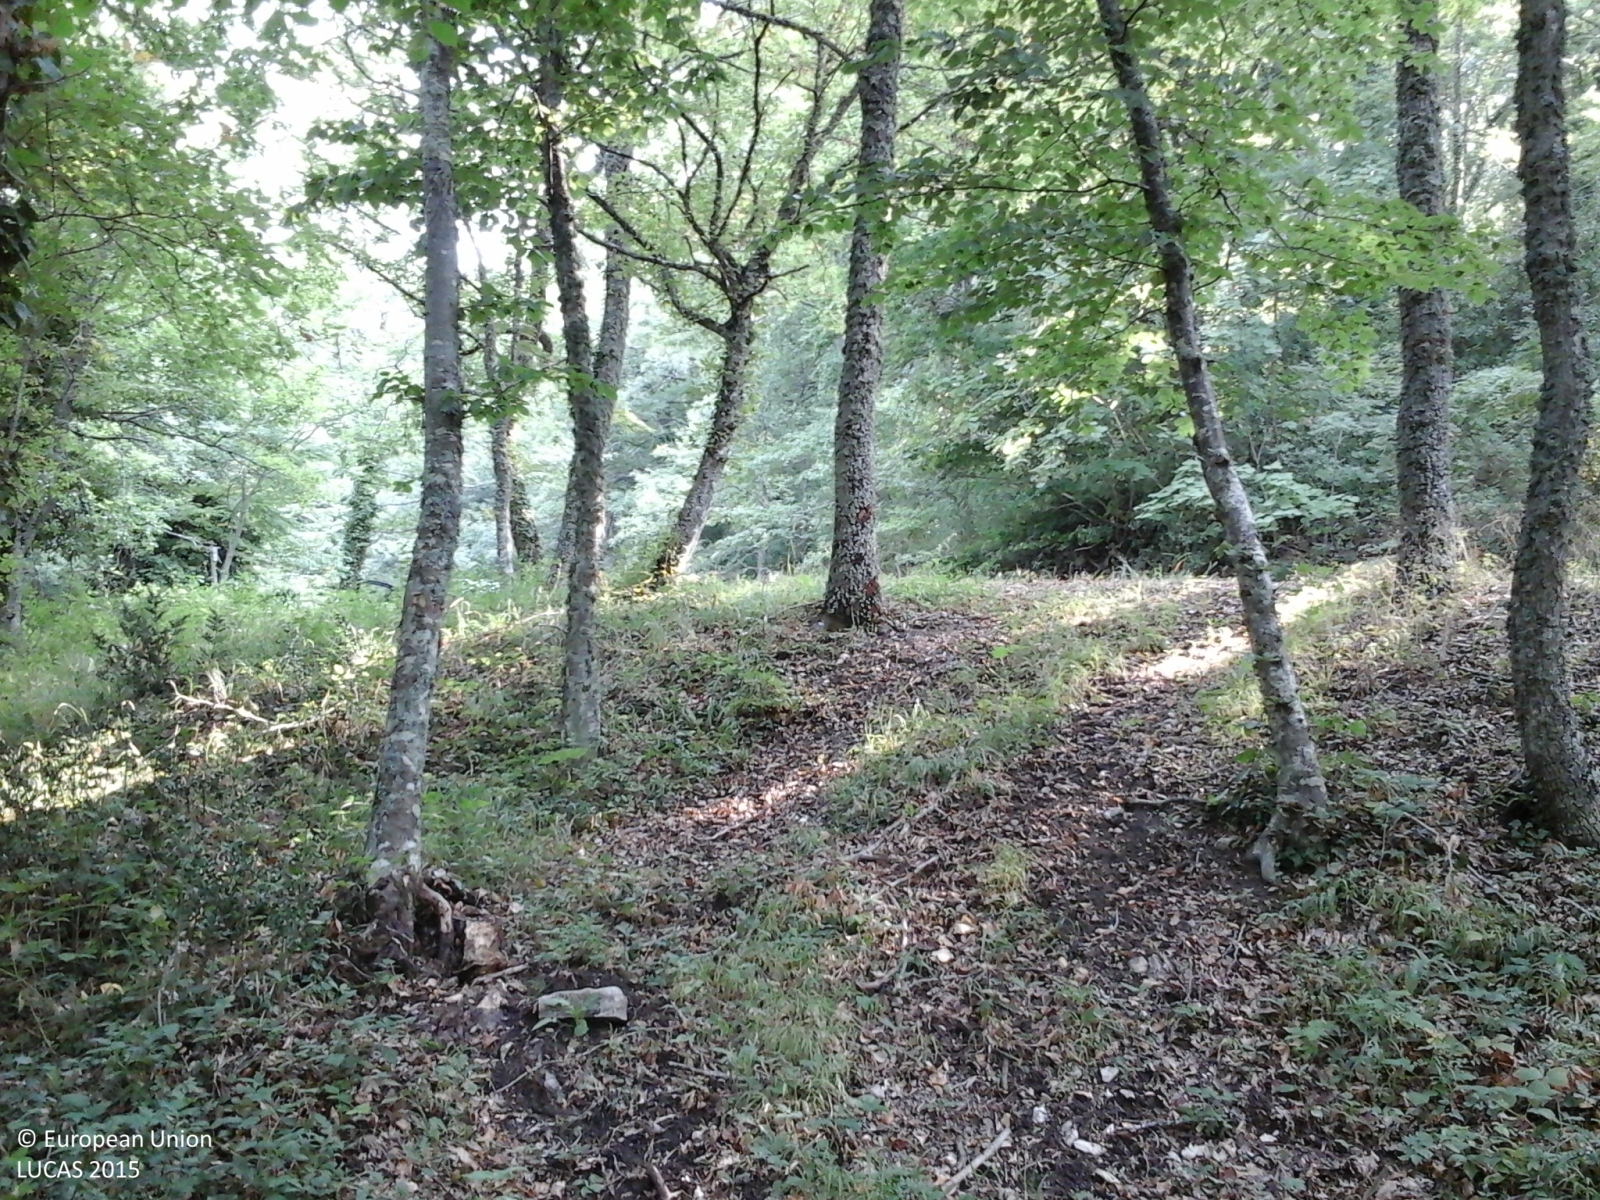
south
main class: Woodland
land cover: Broadleaved woodland
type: beech forest
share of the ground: > 75 %
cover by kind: broadleaved forest trees 70 %, shrubs 30 %
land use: Semi-natural and natural areas not in use
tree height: > 5 m
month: August
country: IT
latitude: 41.3820
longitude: 15.1599
